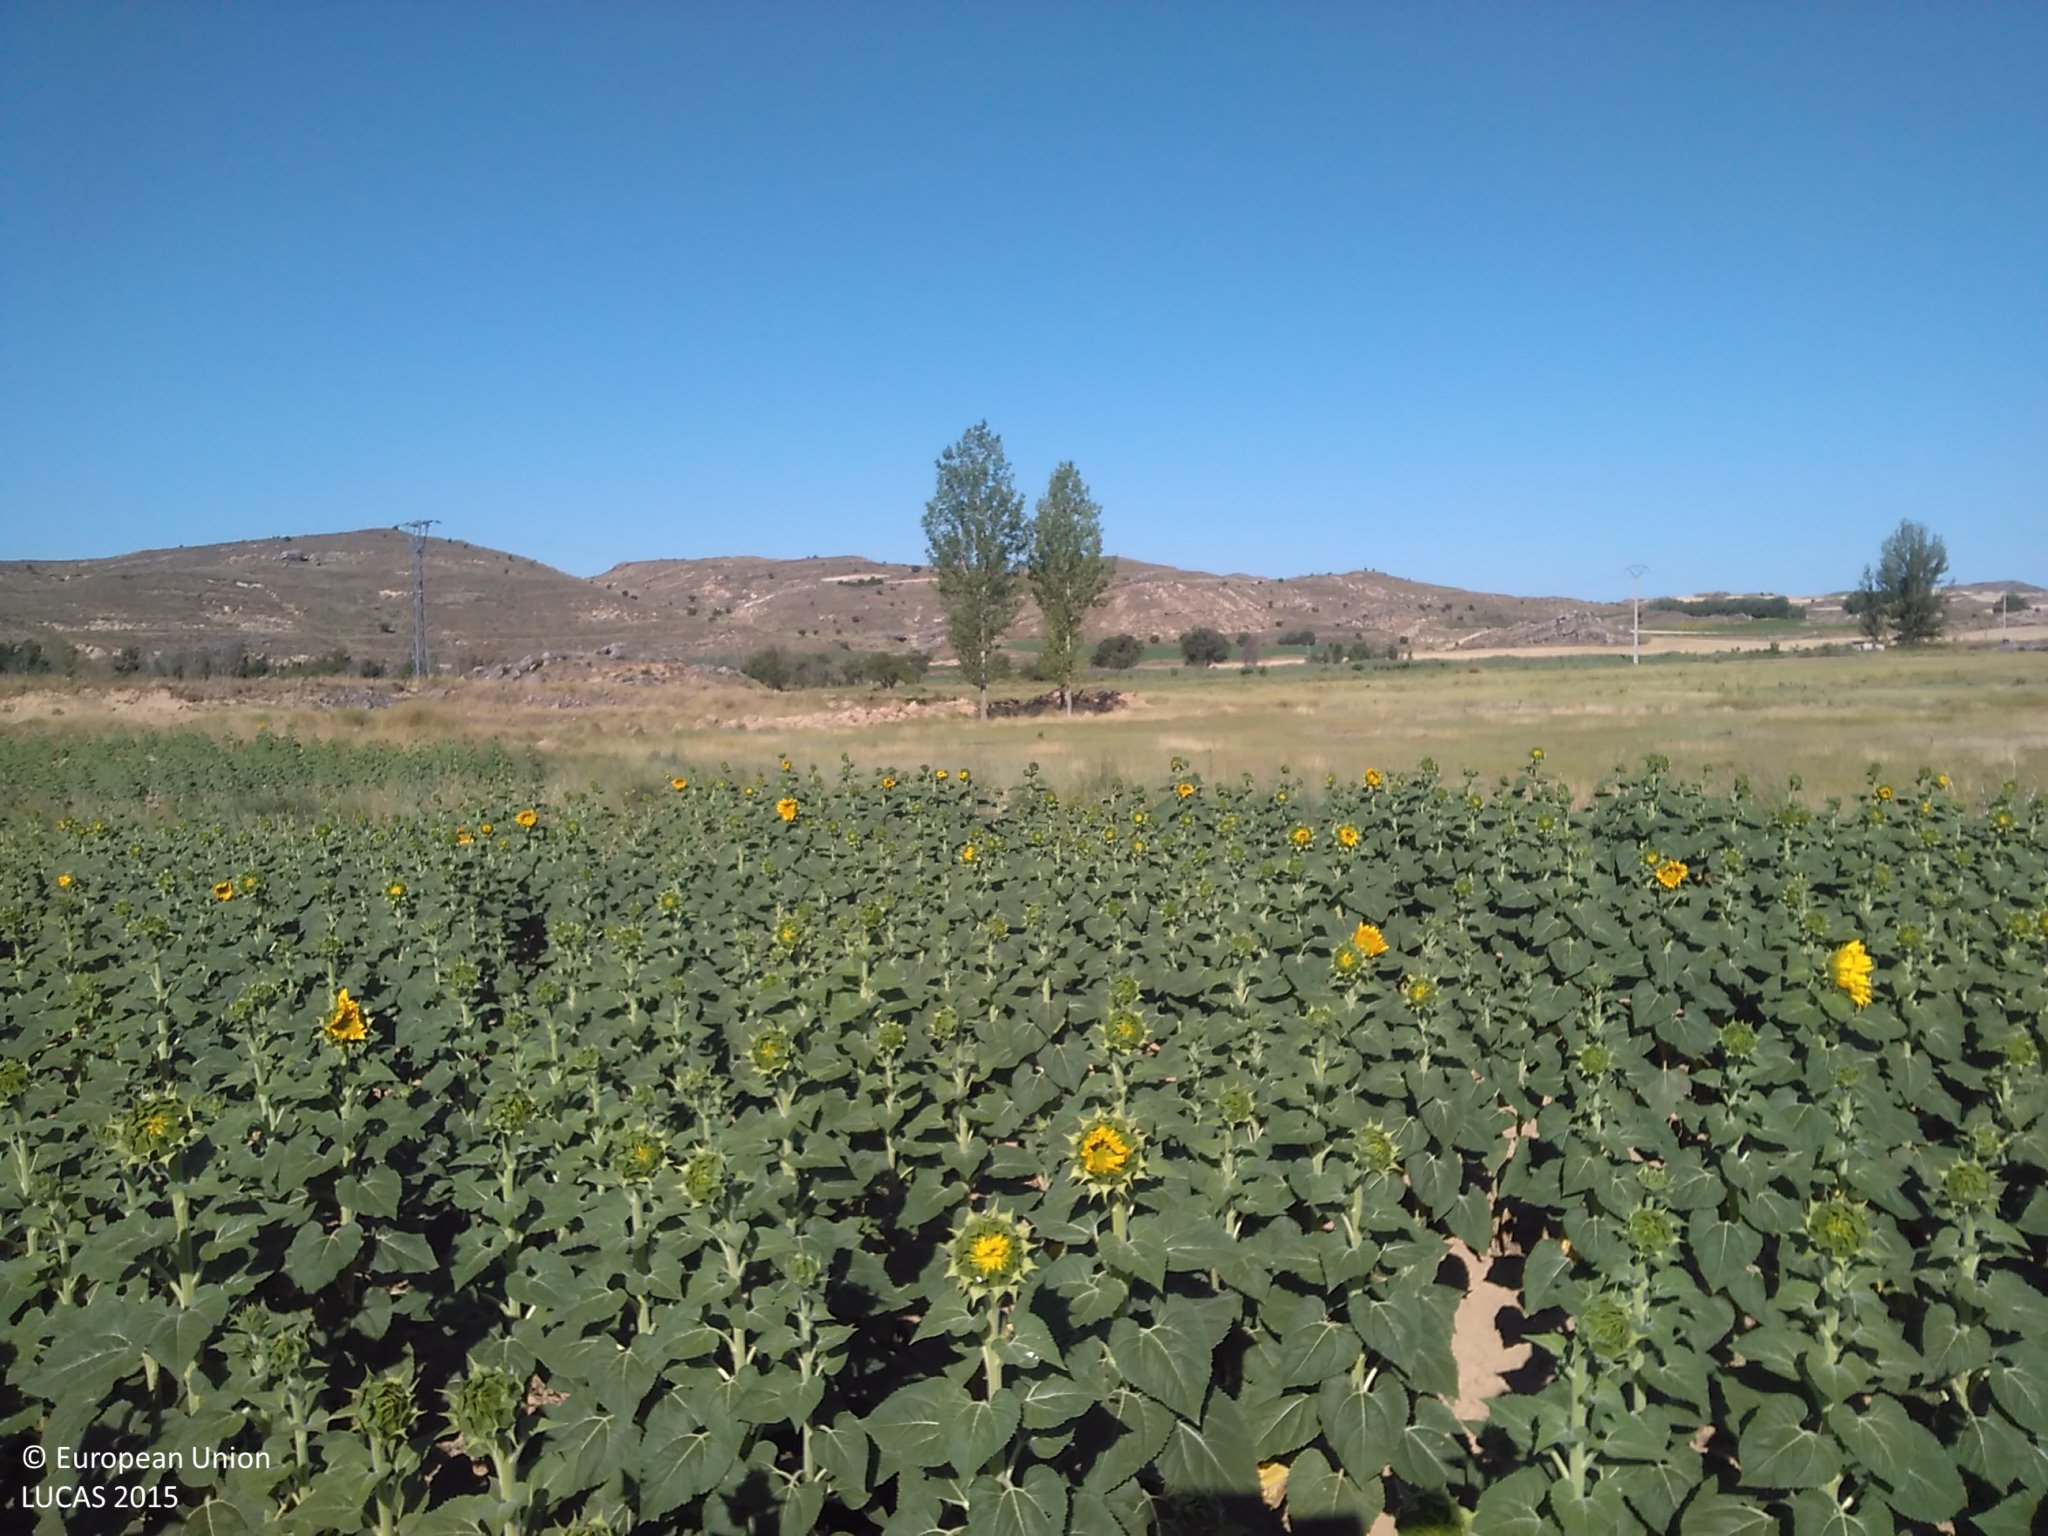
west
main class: Cropland
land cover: Sunflower
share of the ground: 50 - 75 %
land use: Agriculture (excluding fallow land and kitchen gardens)
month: July
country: ES
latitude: 41.5244
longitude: -2.0993
